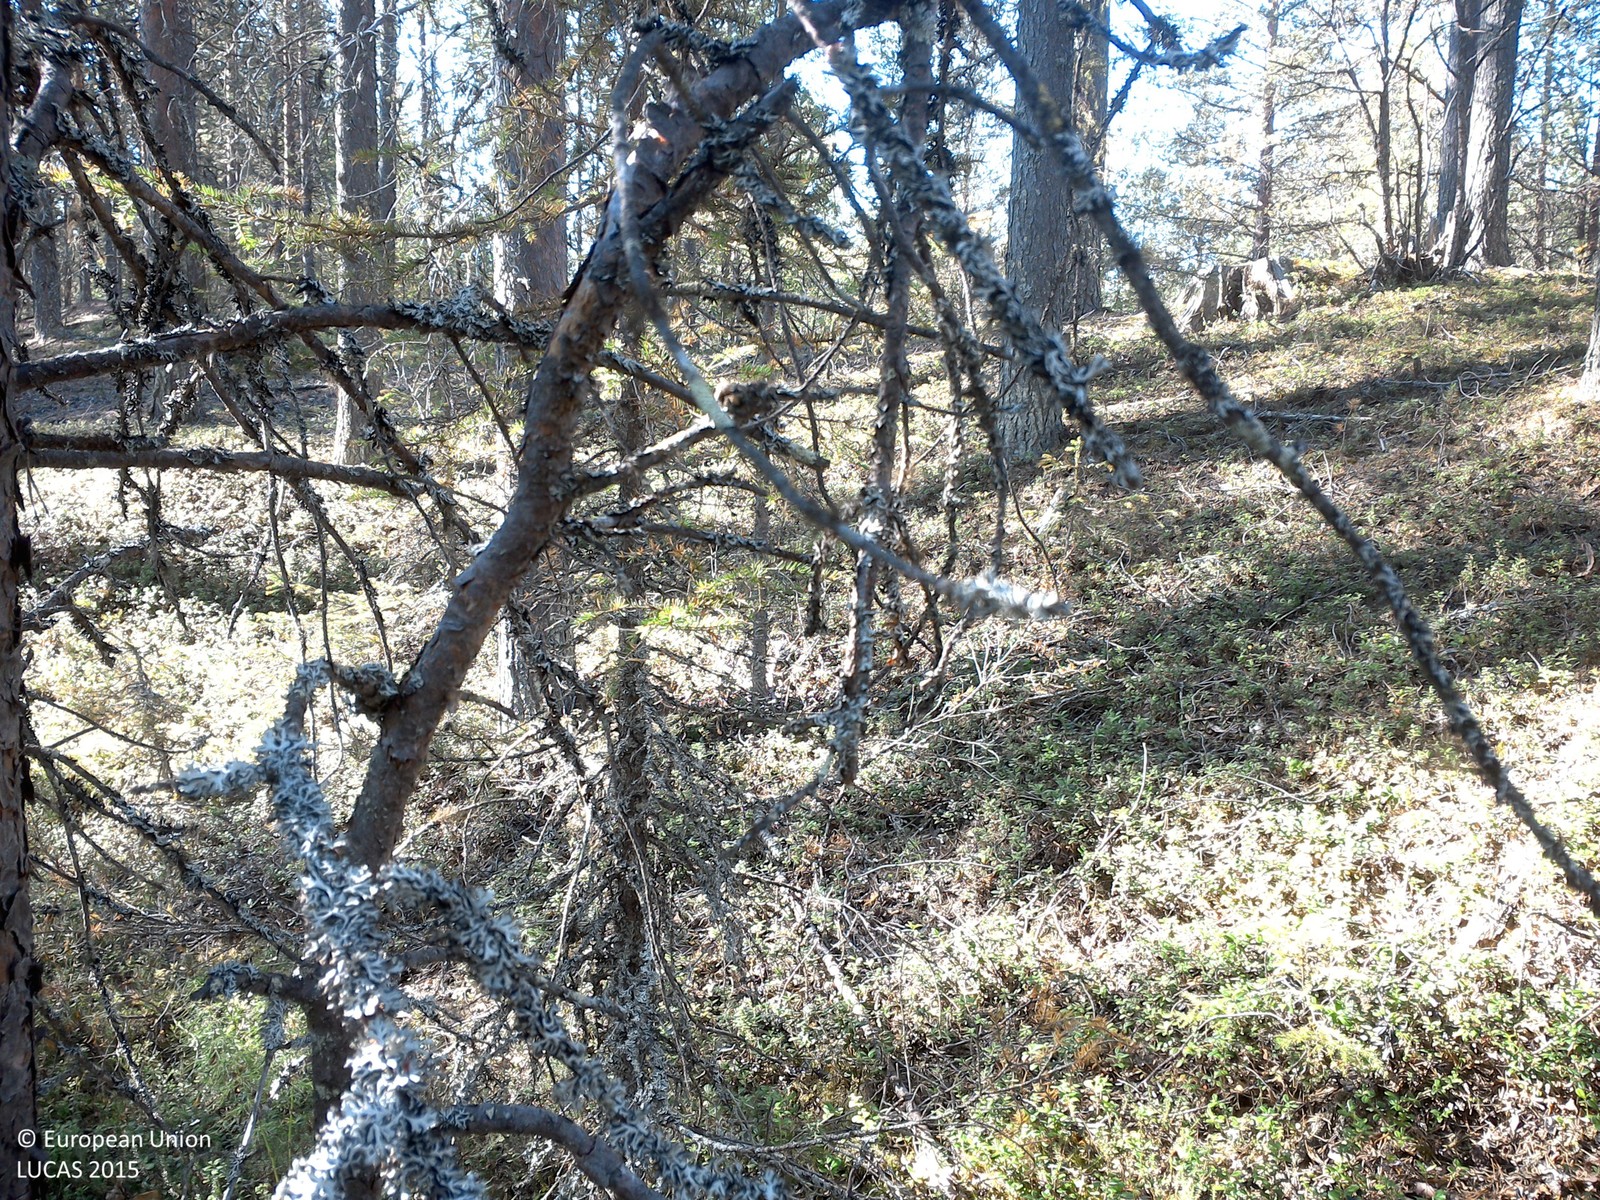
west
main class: Woodland
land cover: Pine dominated coniferous woodland
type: boreal forest
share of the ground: 25 - 50 %
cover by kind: shrubs 50 %, coniferous forest trees 35 %, lichens and mosses 15 %
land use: Forestry
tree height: > 5 m
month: August
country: SE
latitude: 67.0420
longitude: 21.9749
